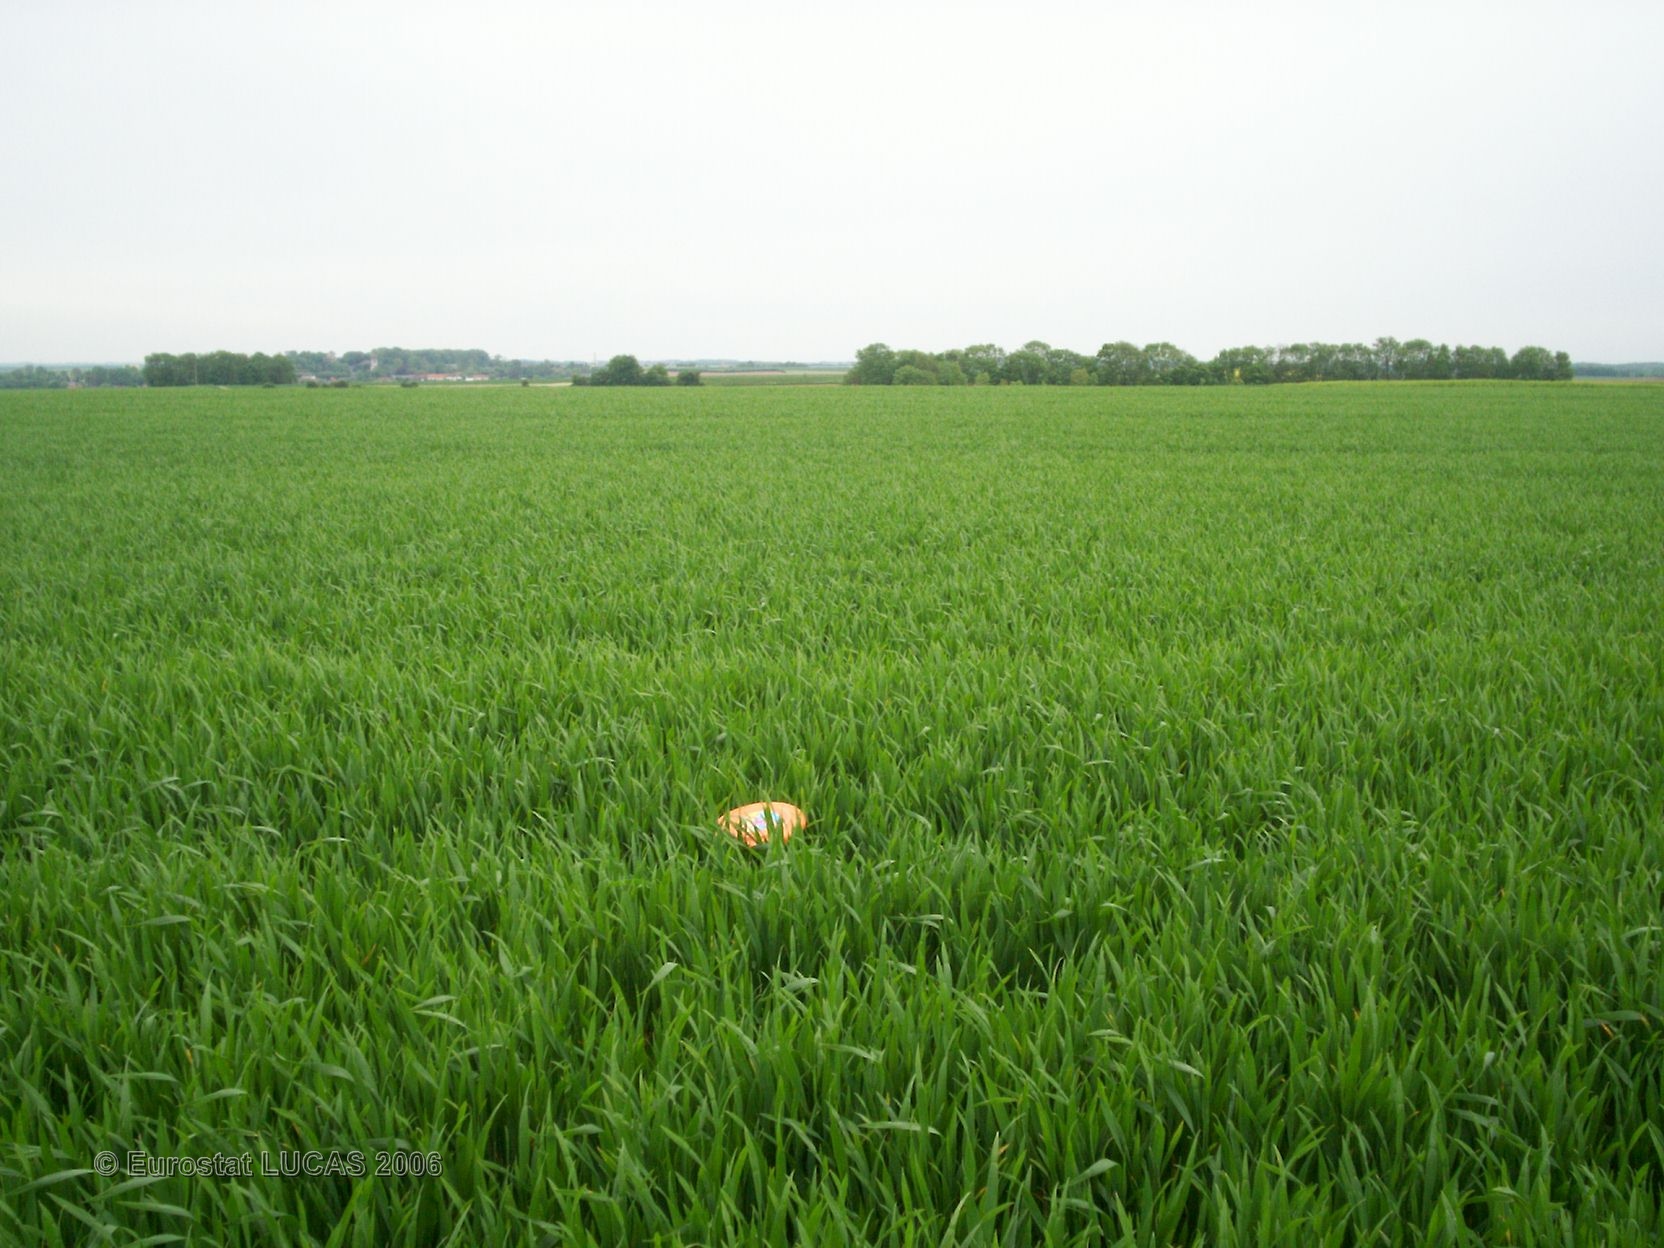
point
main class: Cropland
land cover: Common wheat
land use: Agriculture (excluding fallow land and kitchen gardens)
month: May
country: FR
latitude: 50.2898
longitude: 2.6475
